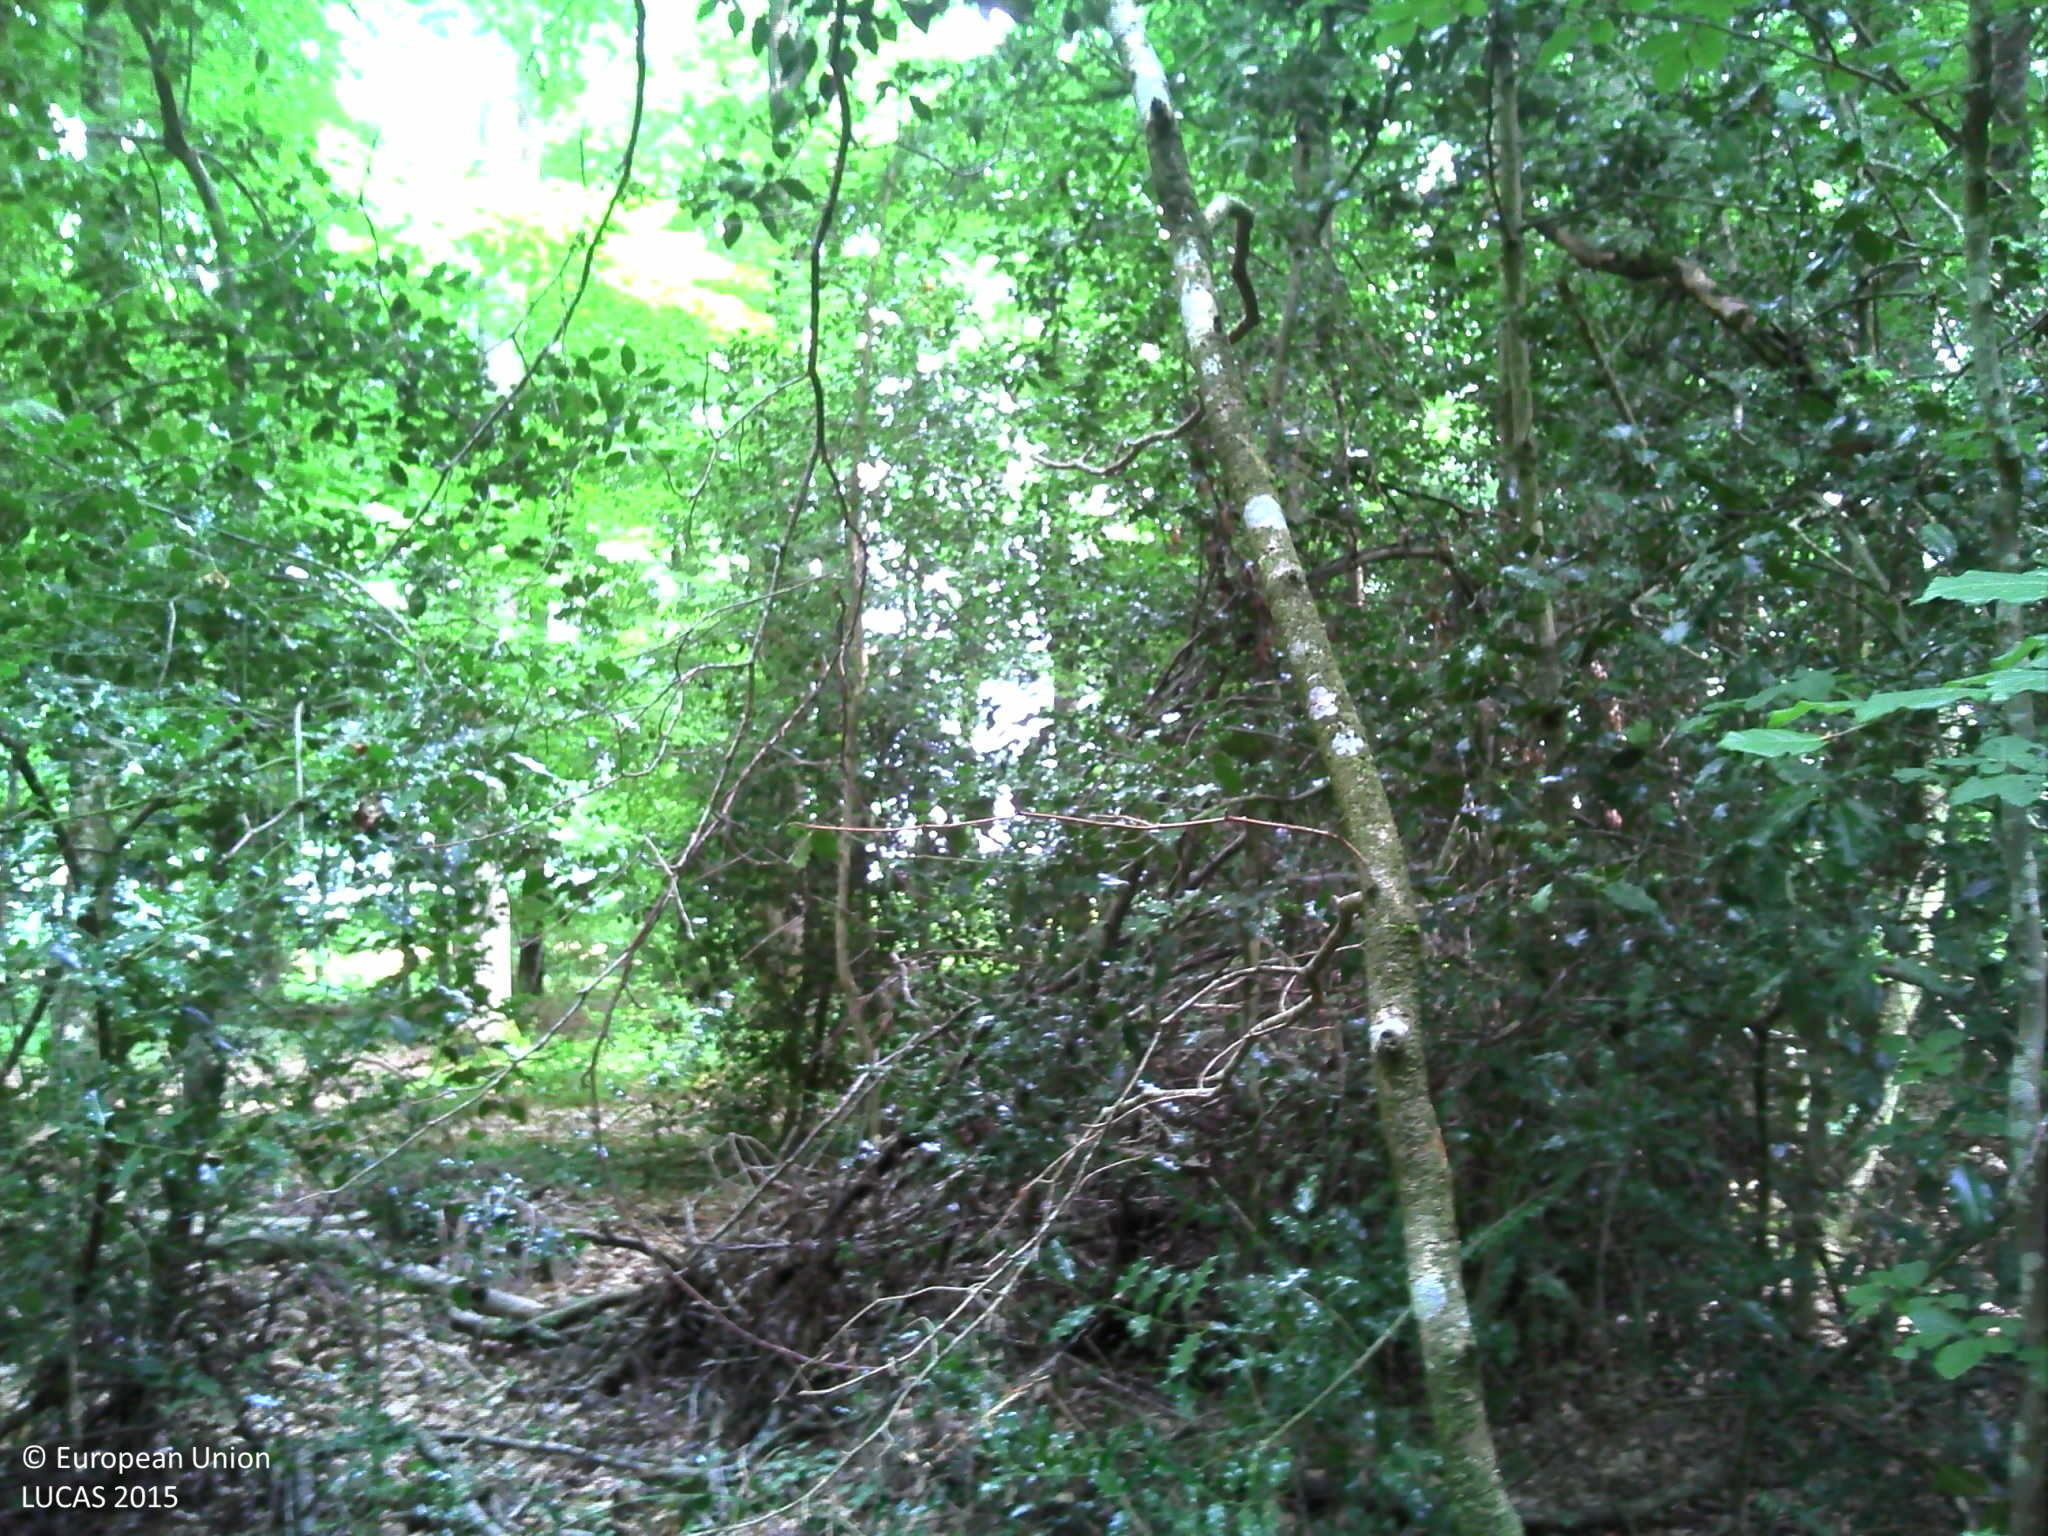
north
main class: Woodland
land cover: Broadleaved woodland
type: acidophilous oak and oak-birch forest
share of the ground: > 75 %
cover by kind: broadleaved forest trees 65 %, herbaceous plants 25 %, shrubs 10 %
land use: Forestry
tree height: > 5 m
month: July
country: FR
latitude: 47.8241
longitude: 0.4261
